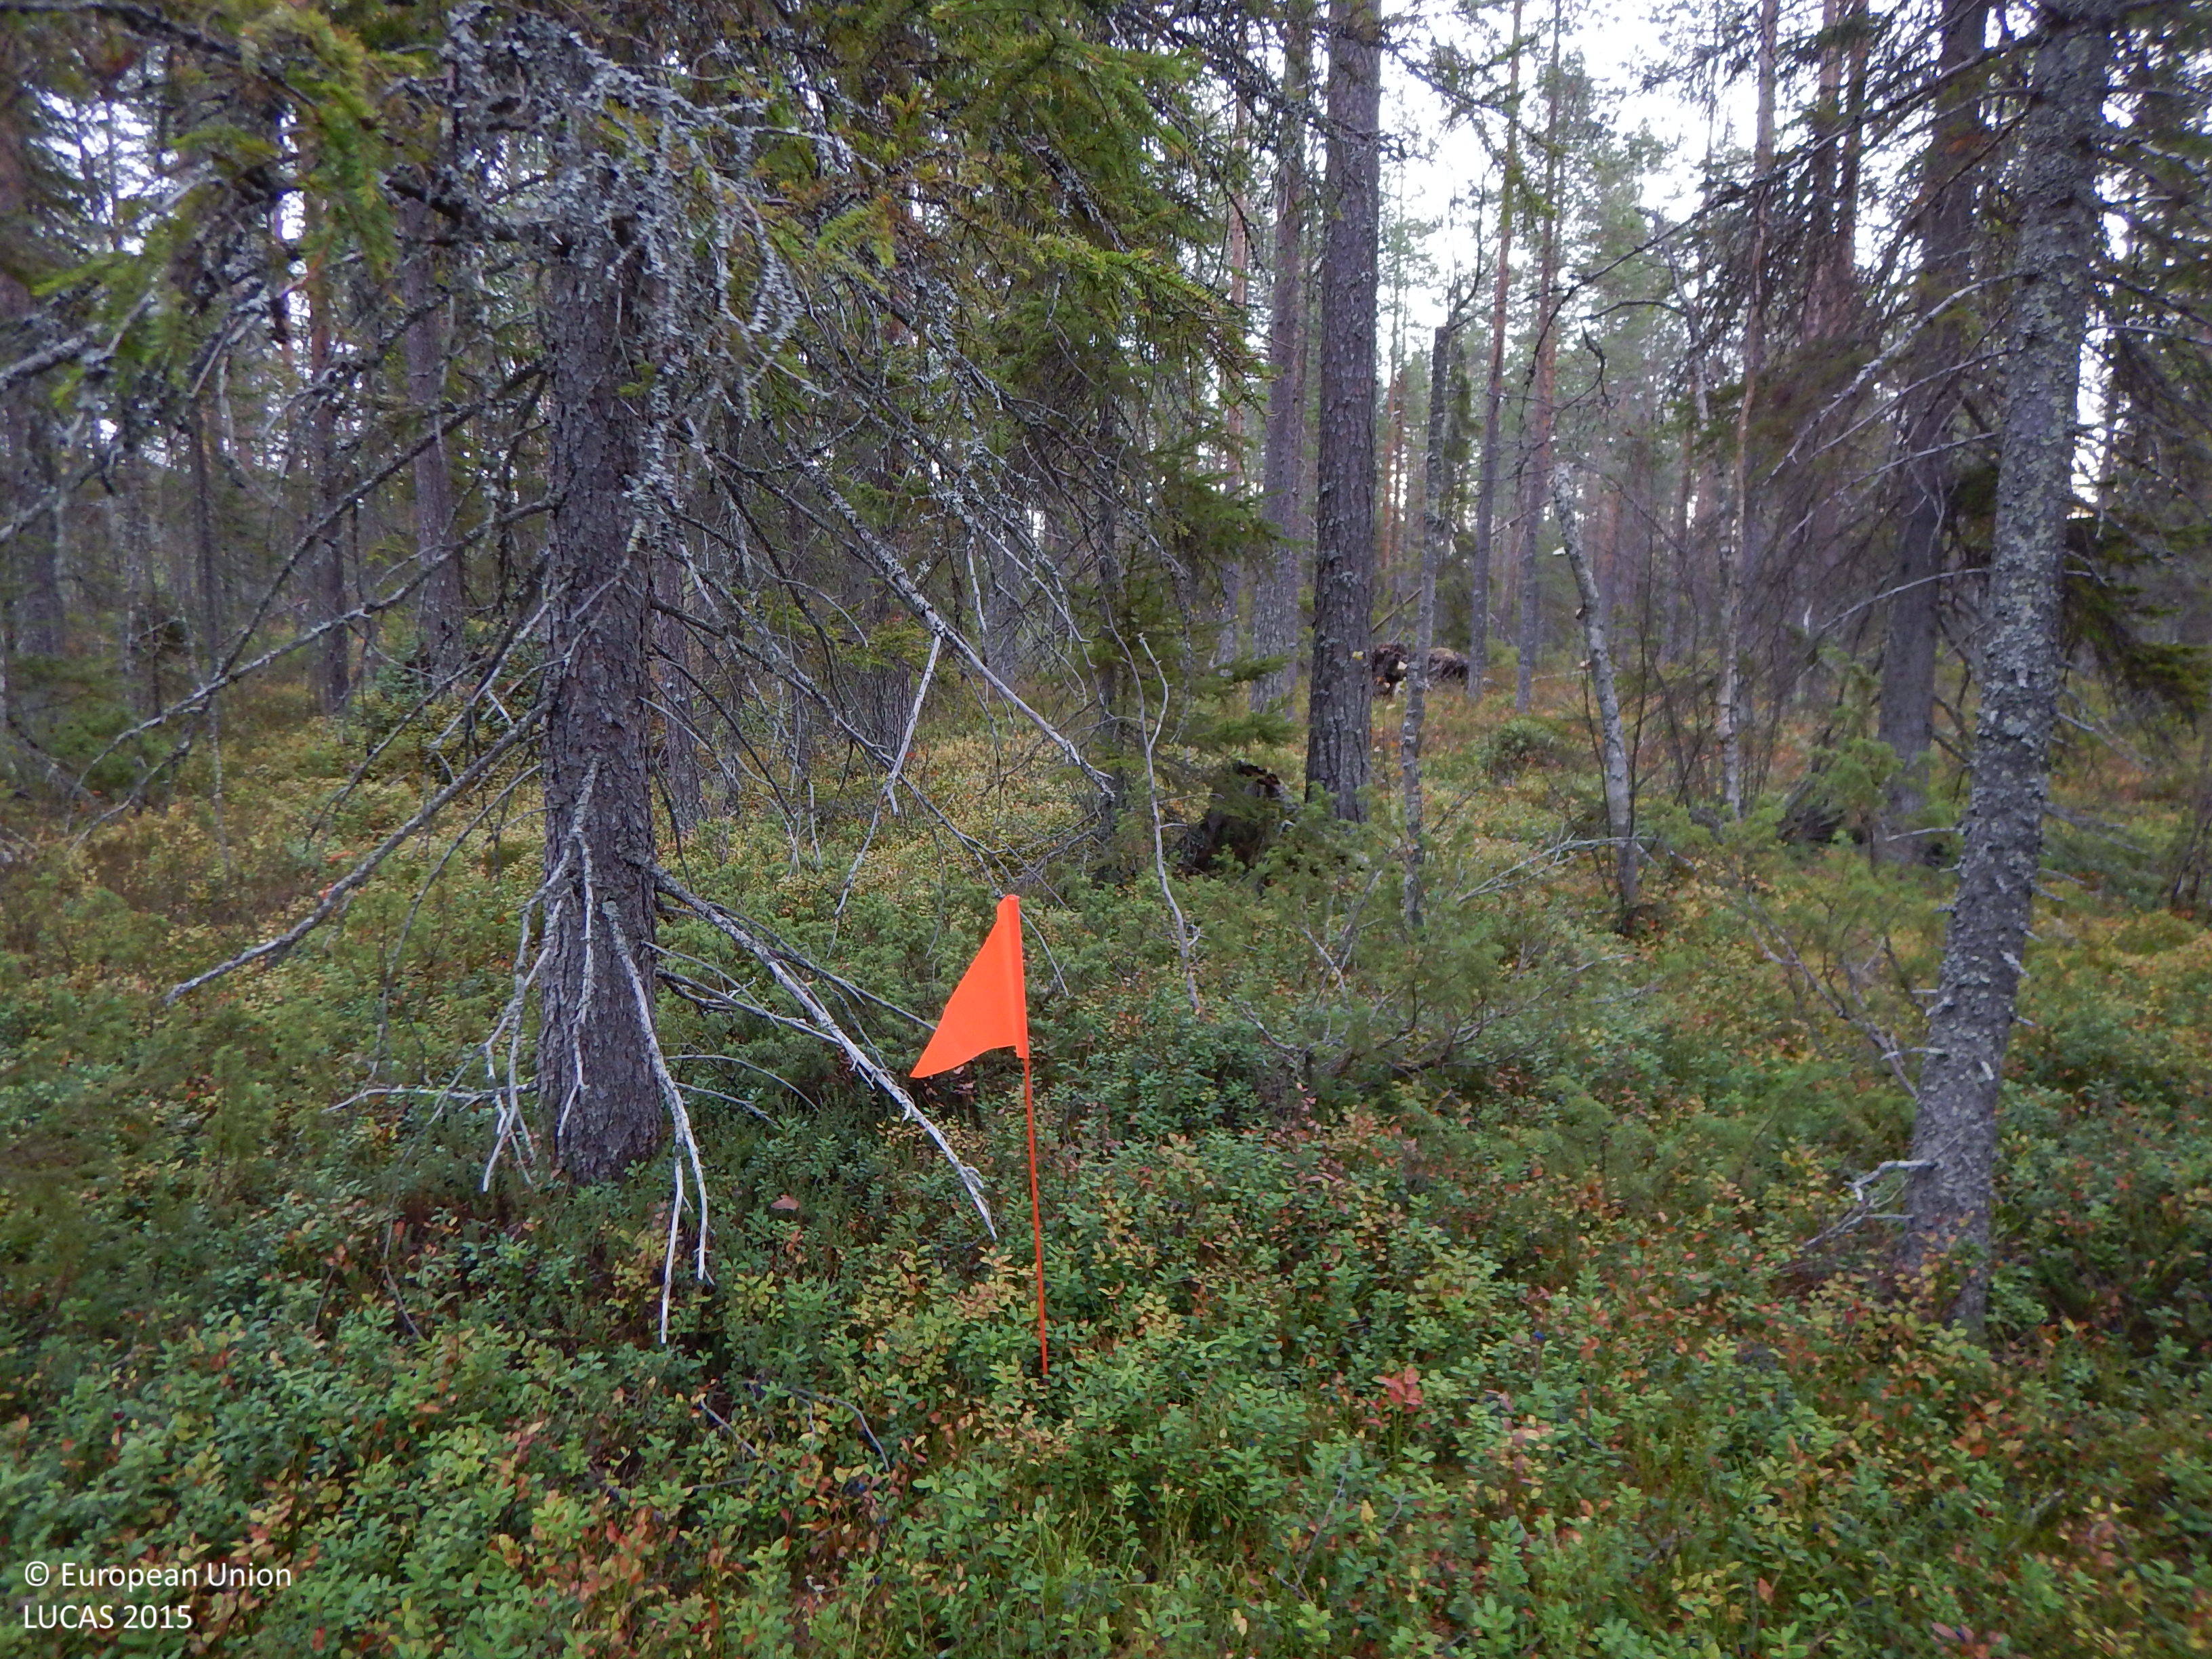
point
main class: Woodland
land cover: Other coniferous woodland
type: boreal forest
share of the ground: 50 - 75 %
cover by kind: coniferous forest trees 60 %, shrubs 20 %, herbaceous plants 10 %, lichens and mosses 10 %
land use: Forestry
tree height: > 5 m
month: October
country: SE
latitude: 65.2077
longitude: 21.1957
